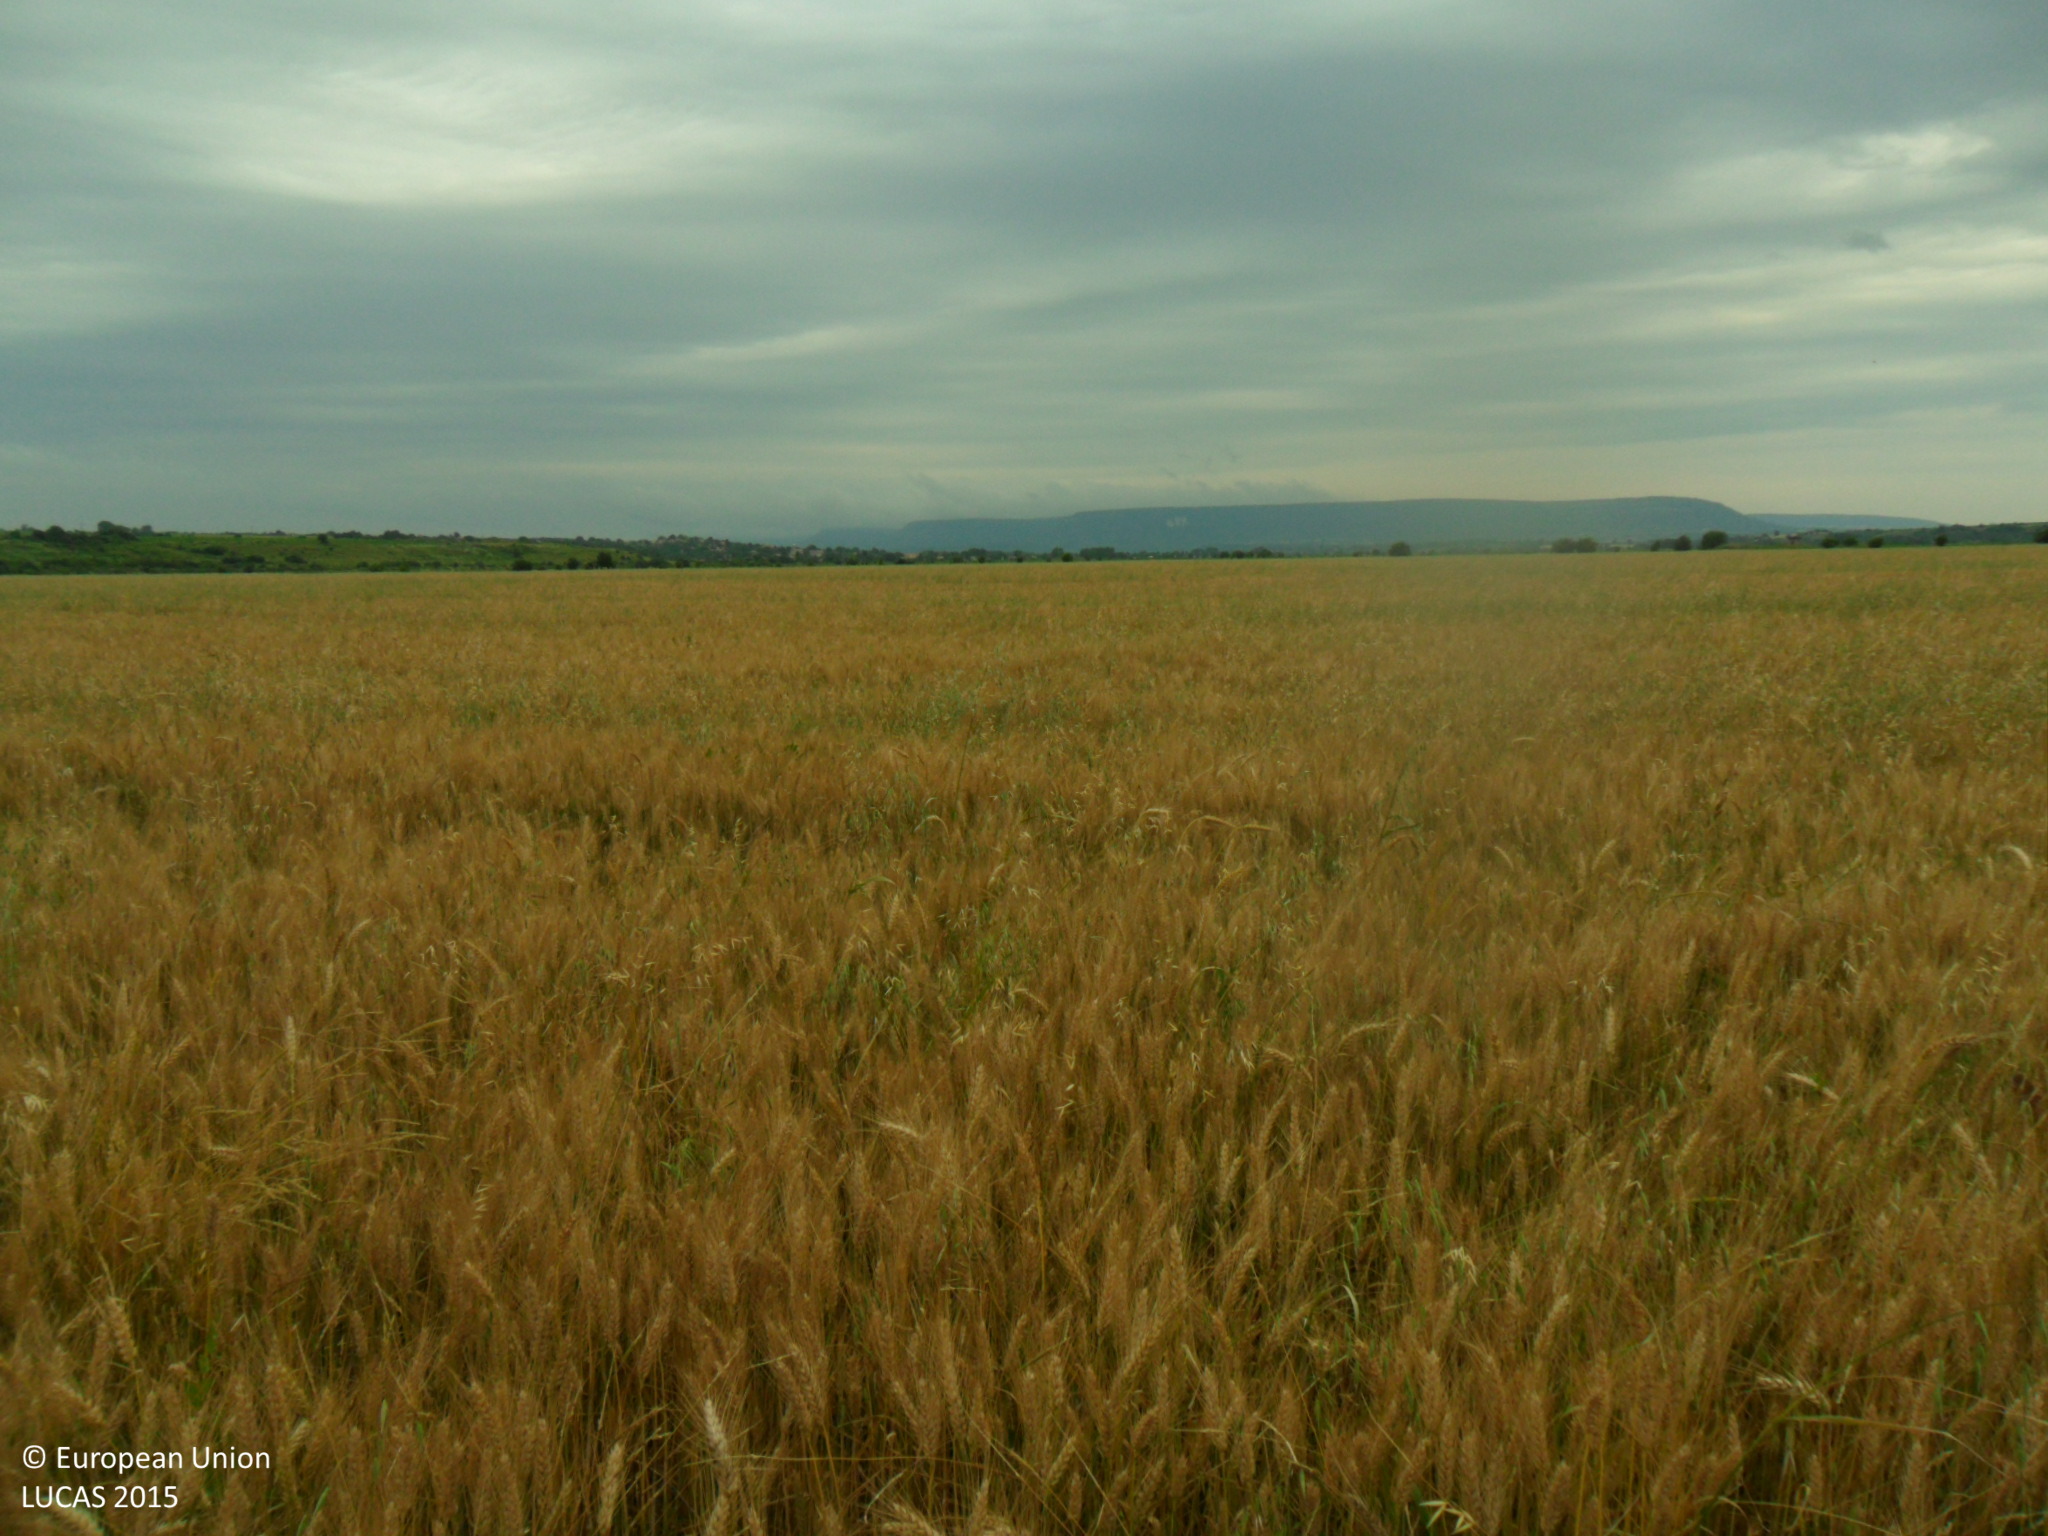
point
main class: Cropland
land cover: Common wheat
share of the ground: > 75 %
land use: Agriculture (excluding fallow land and kitchen gardens)
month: June
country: BG
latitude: 43.1564
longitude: 26.9982
